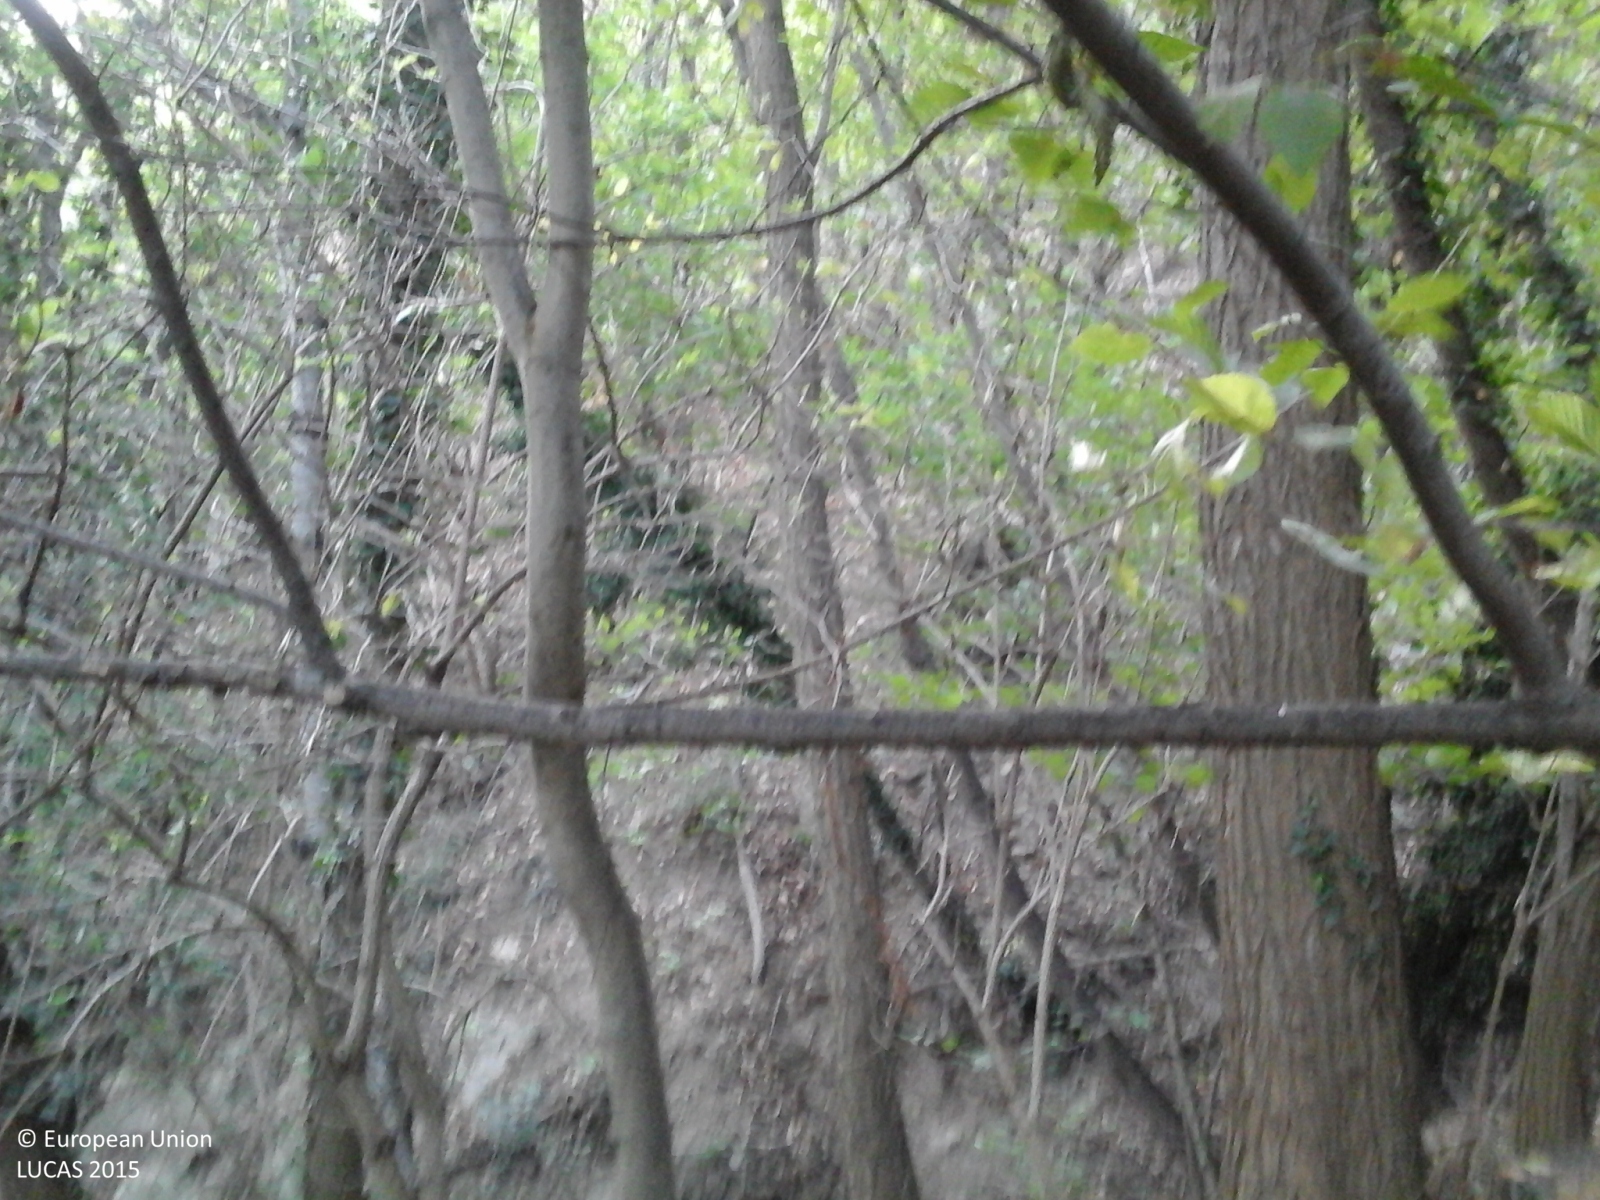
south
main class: Woodland
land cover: Broadleaved woodland
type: thermophilous deciduous forest
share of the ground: > 75 %
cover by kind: broadleaved forest trees 100 %
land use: Semi-natural and natural areas not in use
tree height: > 5 m
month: September
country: IT
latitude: 44.3200
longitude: 8.3862
